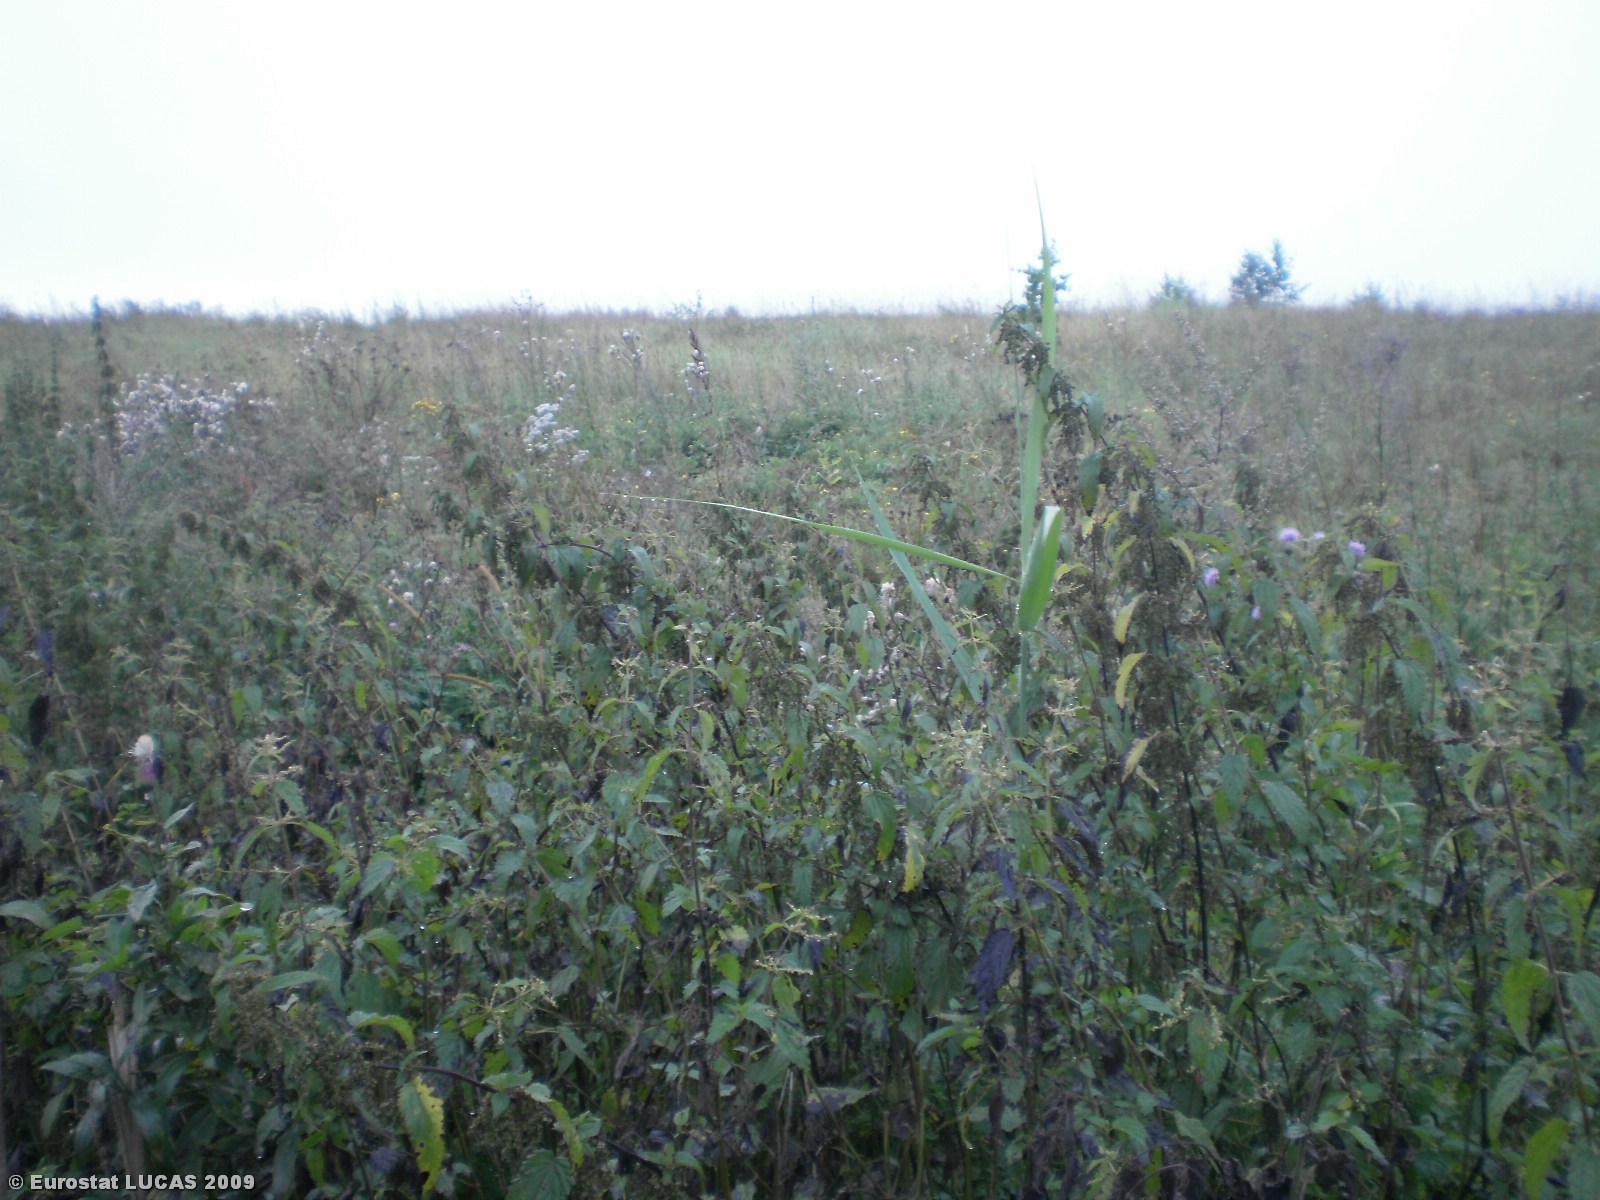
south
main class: Grassland
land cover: Spontaneously vegetated surfaces
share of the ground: > 75 %
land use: Unused
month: August
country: LT
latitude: 55.3747
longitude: 25.5760
